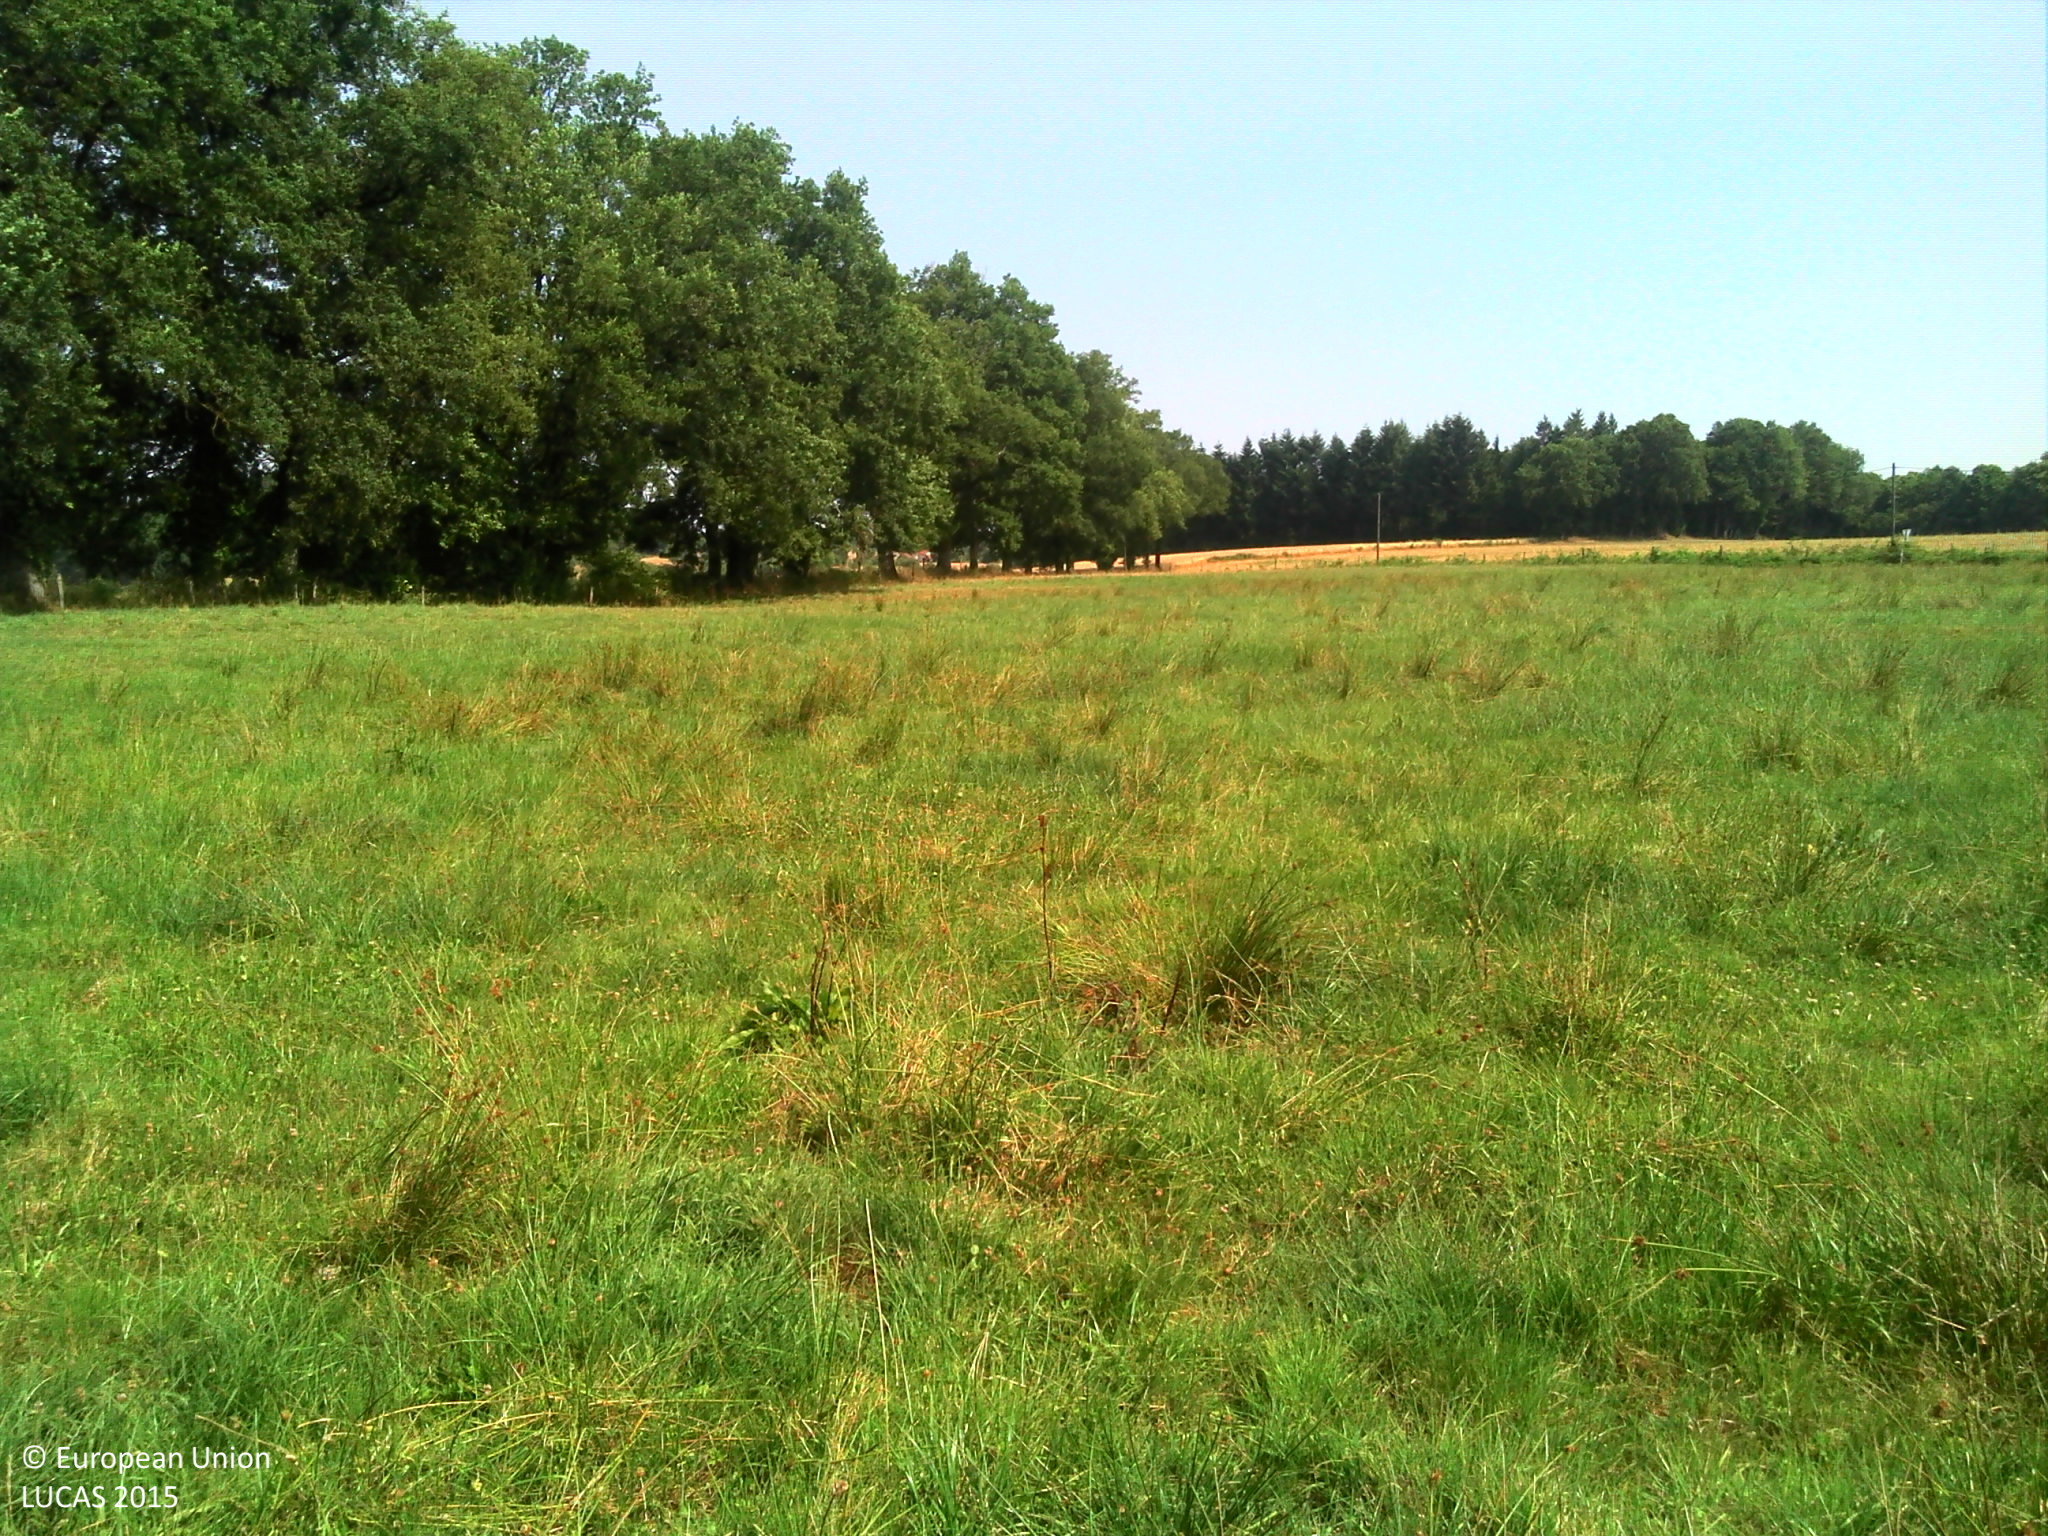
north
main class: Grassland
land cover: Grassland without tree/shrub cover
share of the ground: > 75 %
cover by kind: herbaceous plants 95 %, shrubs 5 %
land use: Agriculture (excluding fallow land and kitchen gardens)
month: July
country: FR
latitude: 46.0470
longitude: 1.7087
